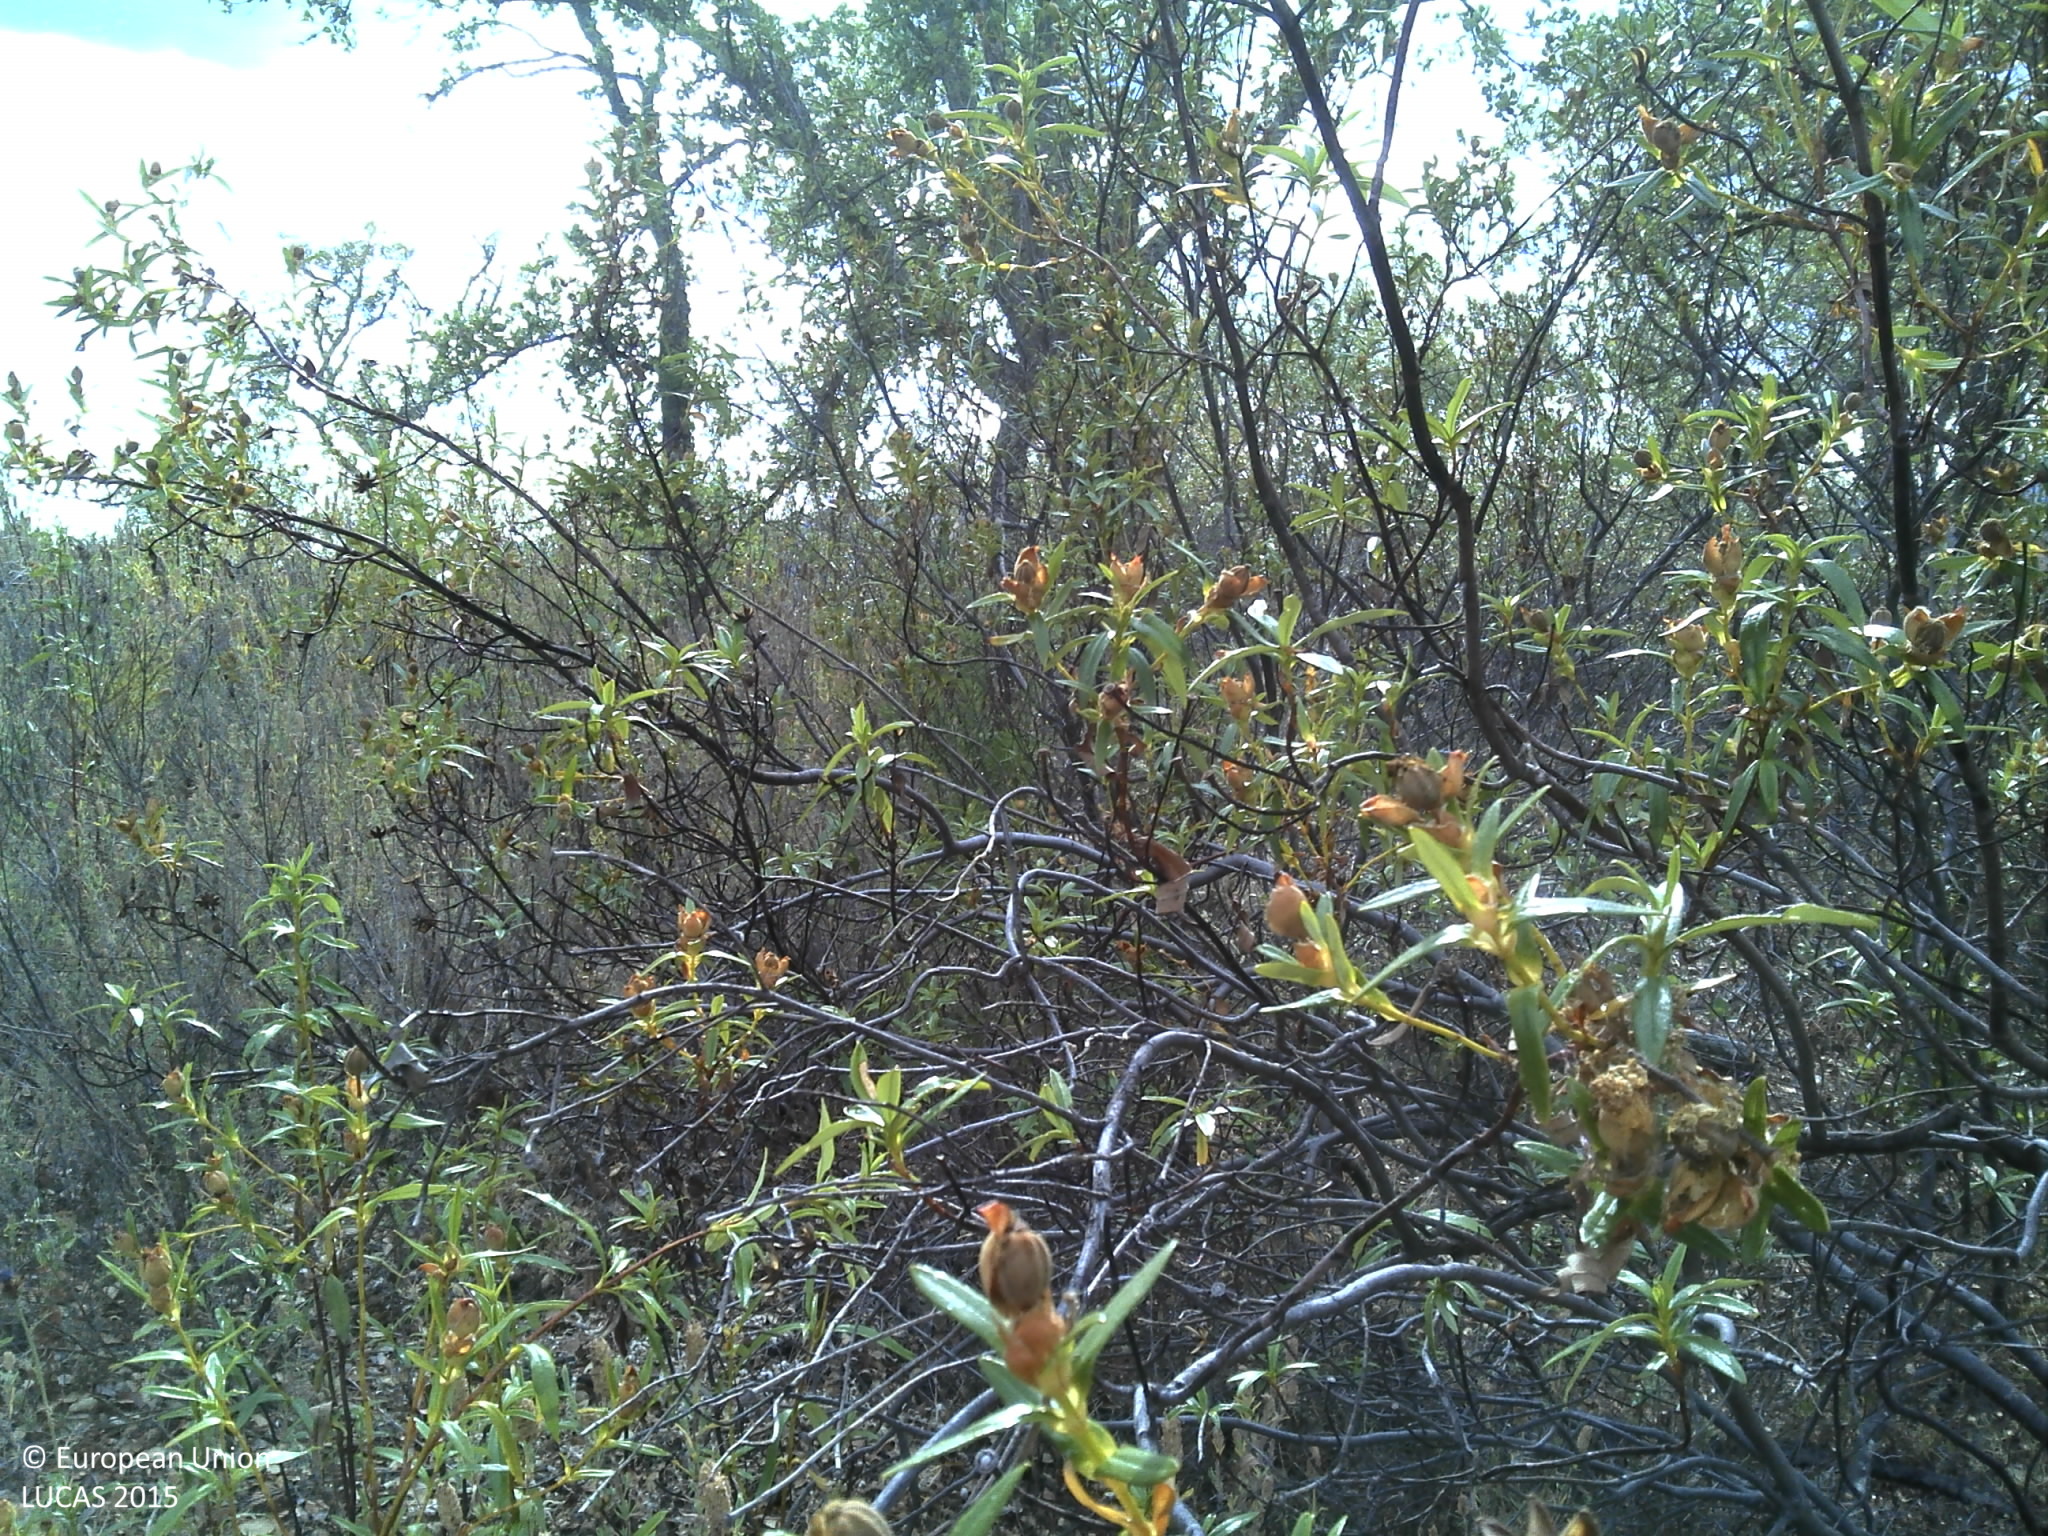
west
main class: Woodland
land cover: Broadleaved woodland
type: broadleaved evergreen forest
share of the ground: 25 - 50 %
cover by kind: broadleaved forest trees 40 %, shrubs 40 %, unconsolidated bare surface 20 %
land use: Forestry
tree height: > 5 m
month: June
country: PT
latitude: 37.2841
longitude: -7.7523
